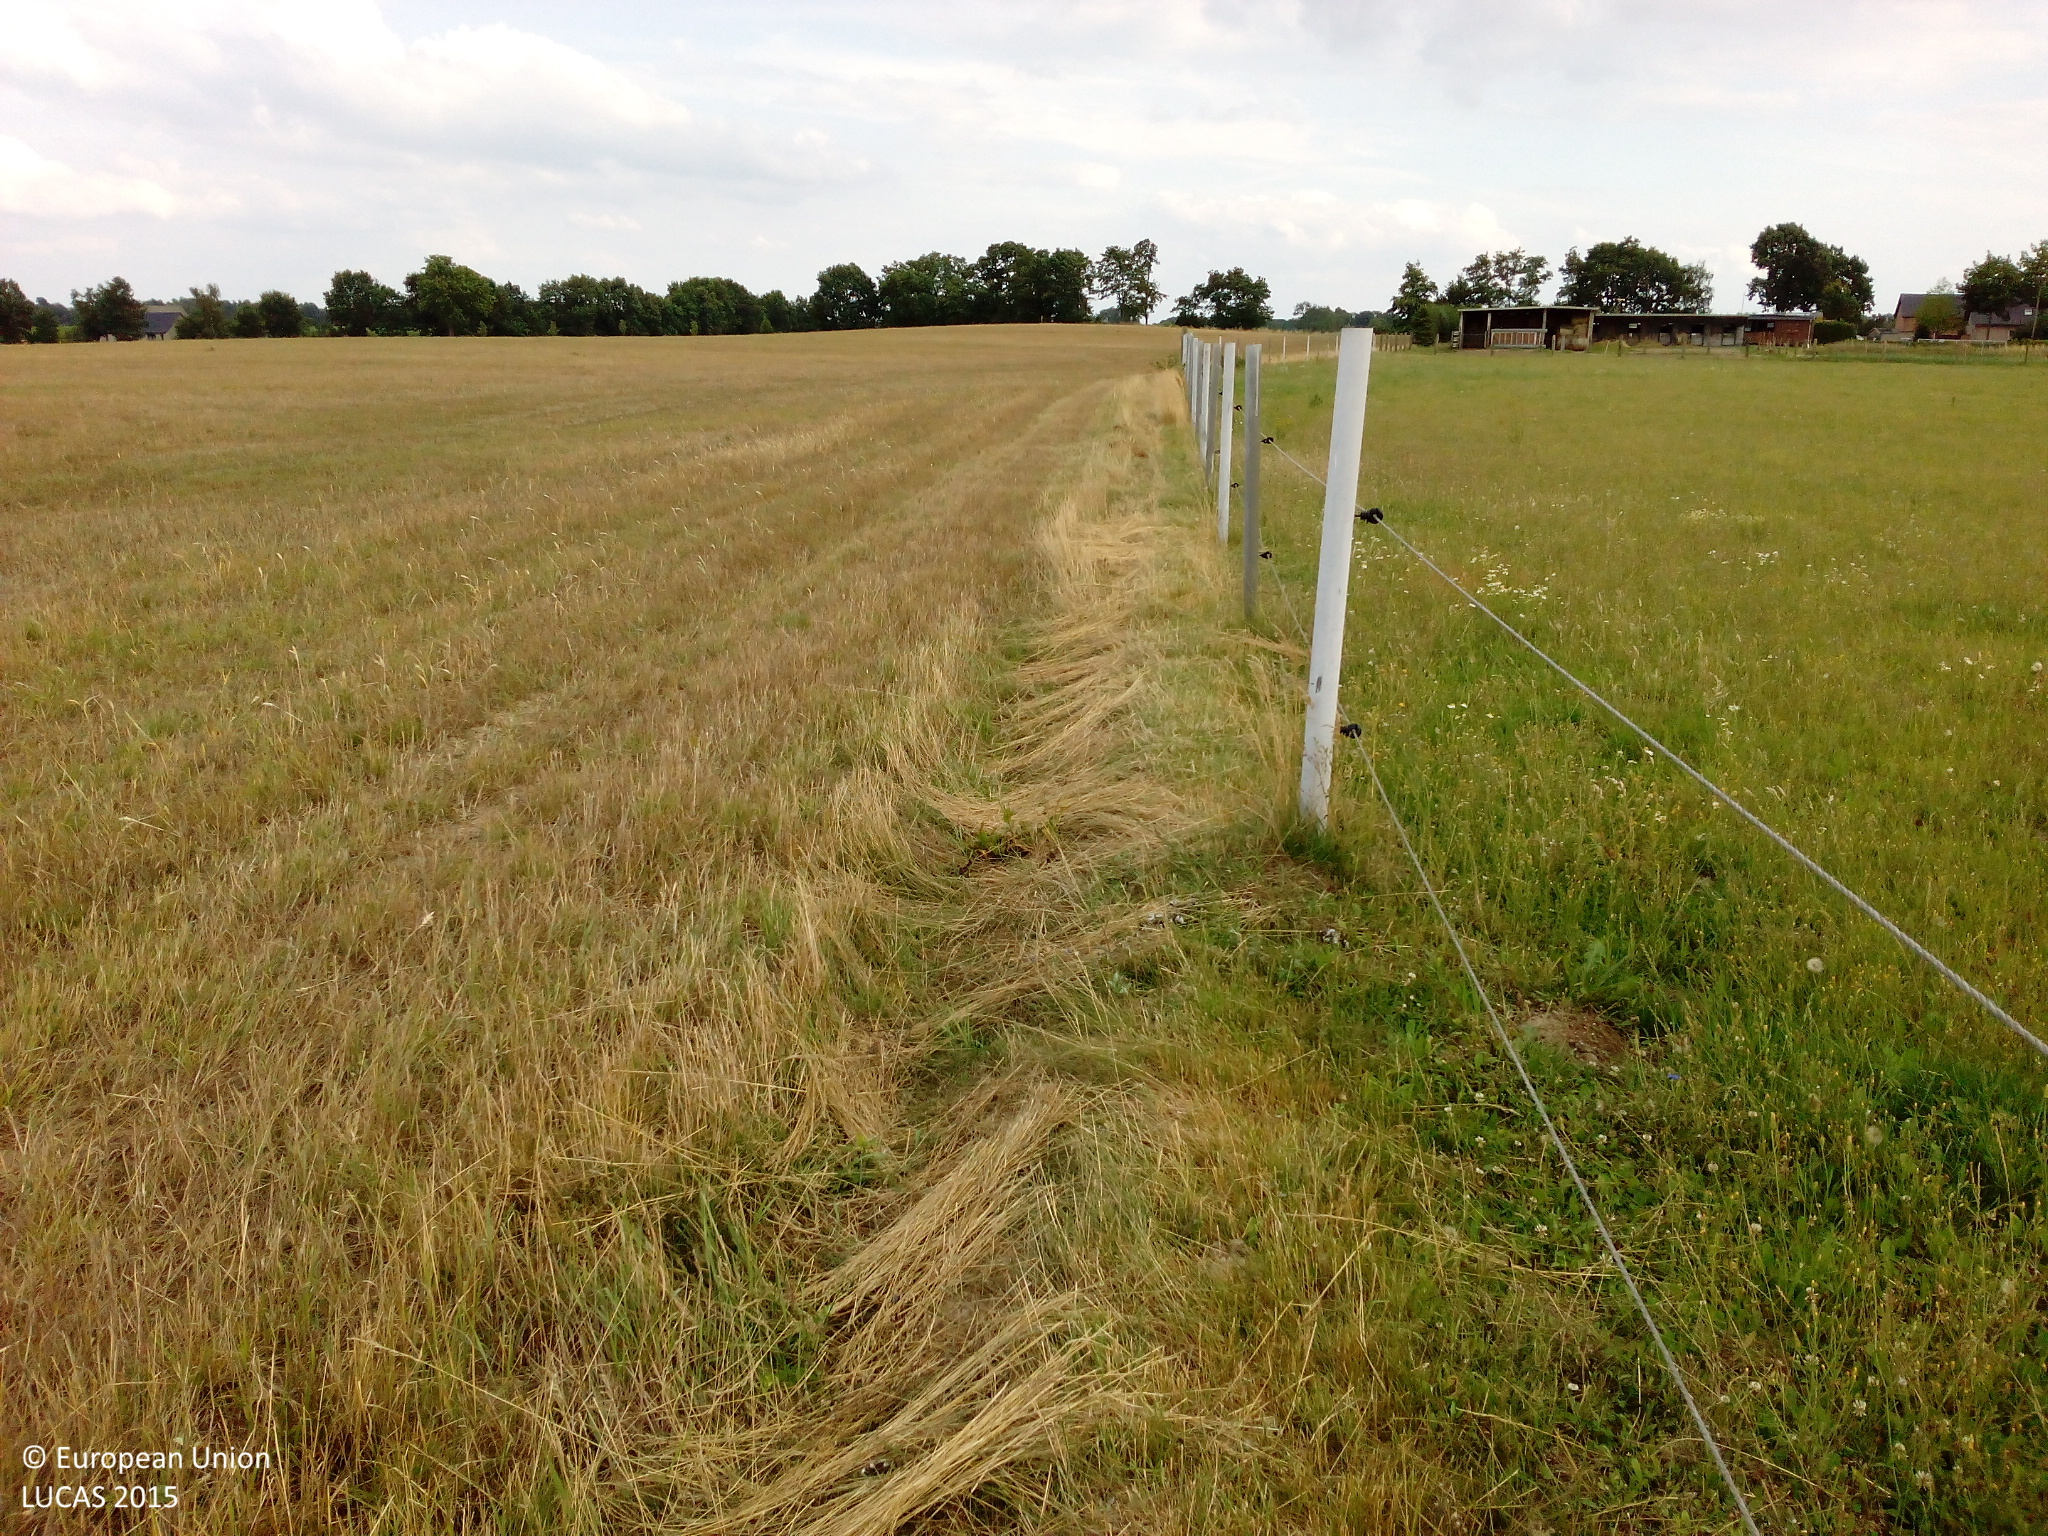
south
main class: Grassland
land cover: Grassland without tree/shrub cover
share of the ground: > 75 %
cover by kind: herbaceous plants 100 %
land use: Agriculture (excluding fallow land and kitchen gardens)
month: July
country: DE
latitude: 52.9479
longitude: 12.3360
